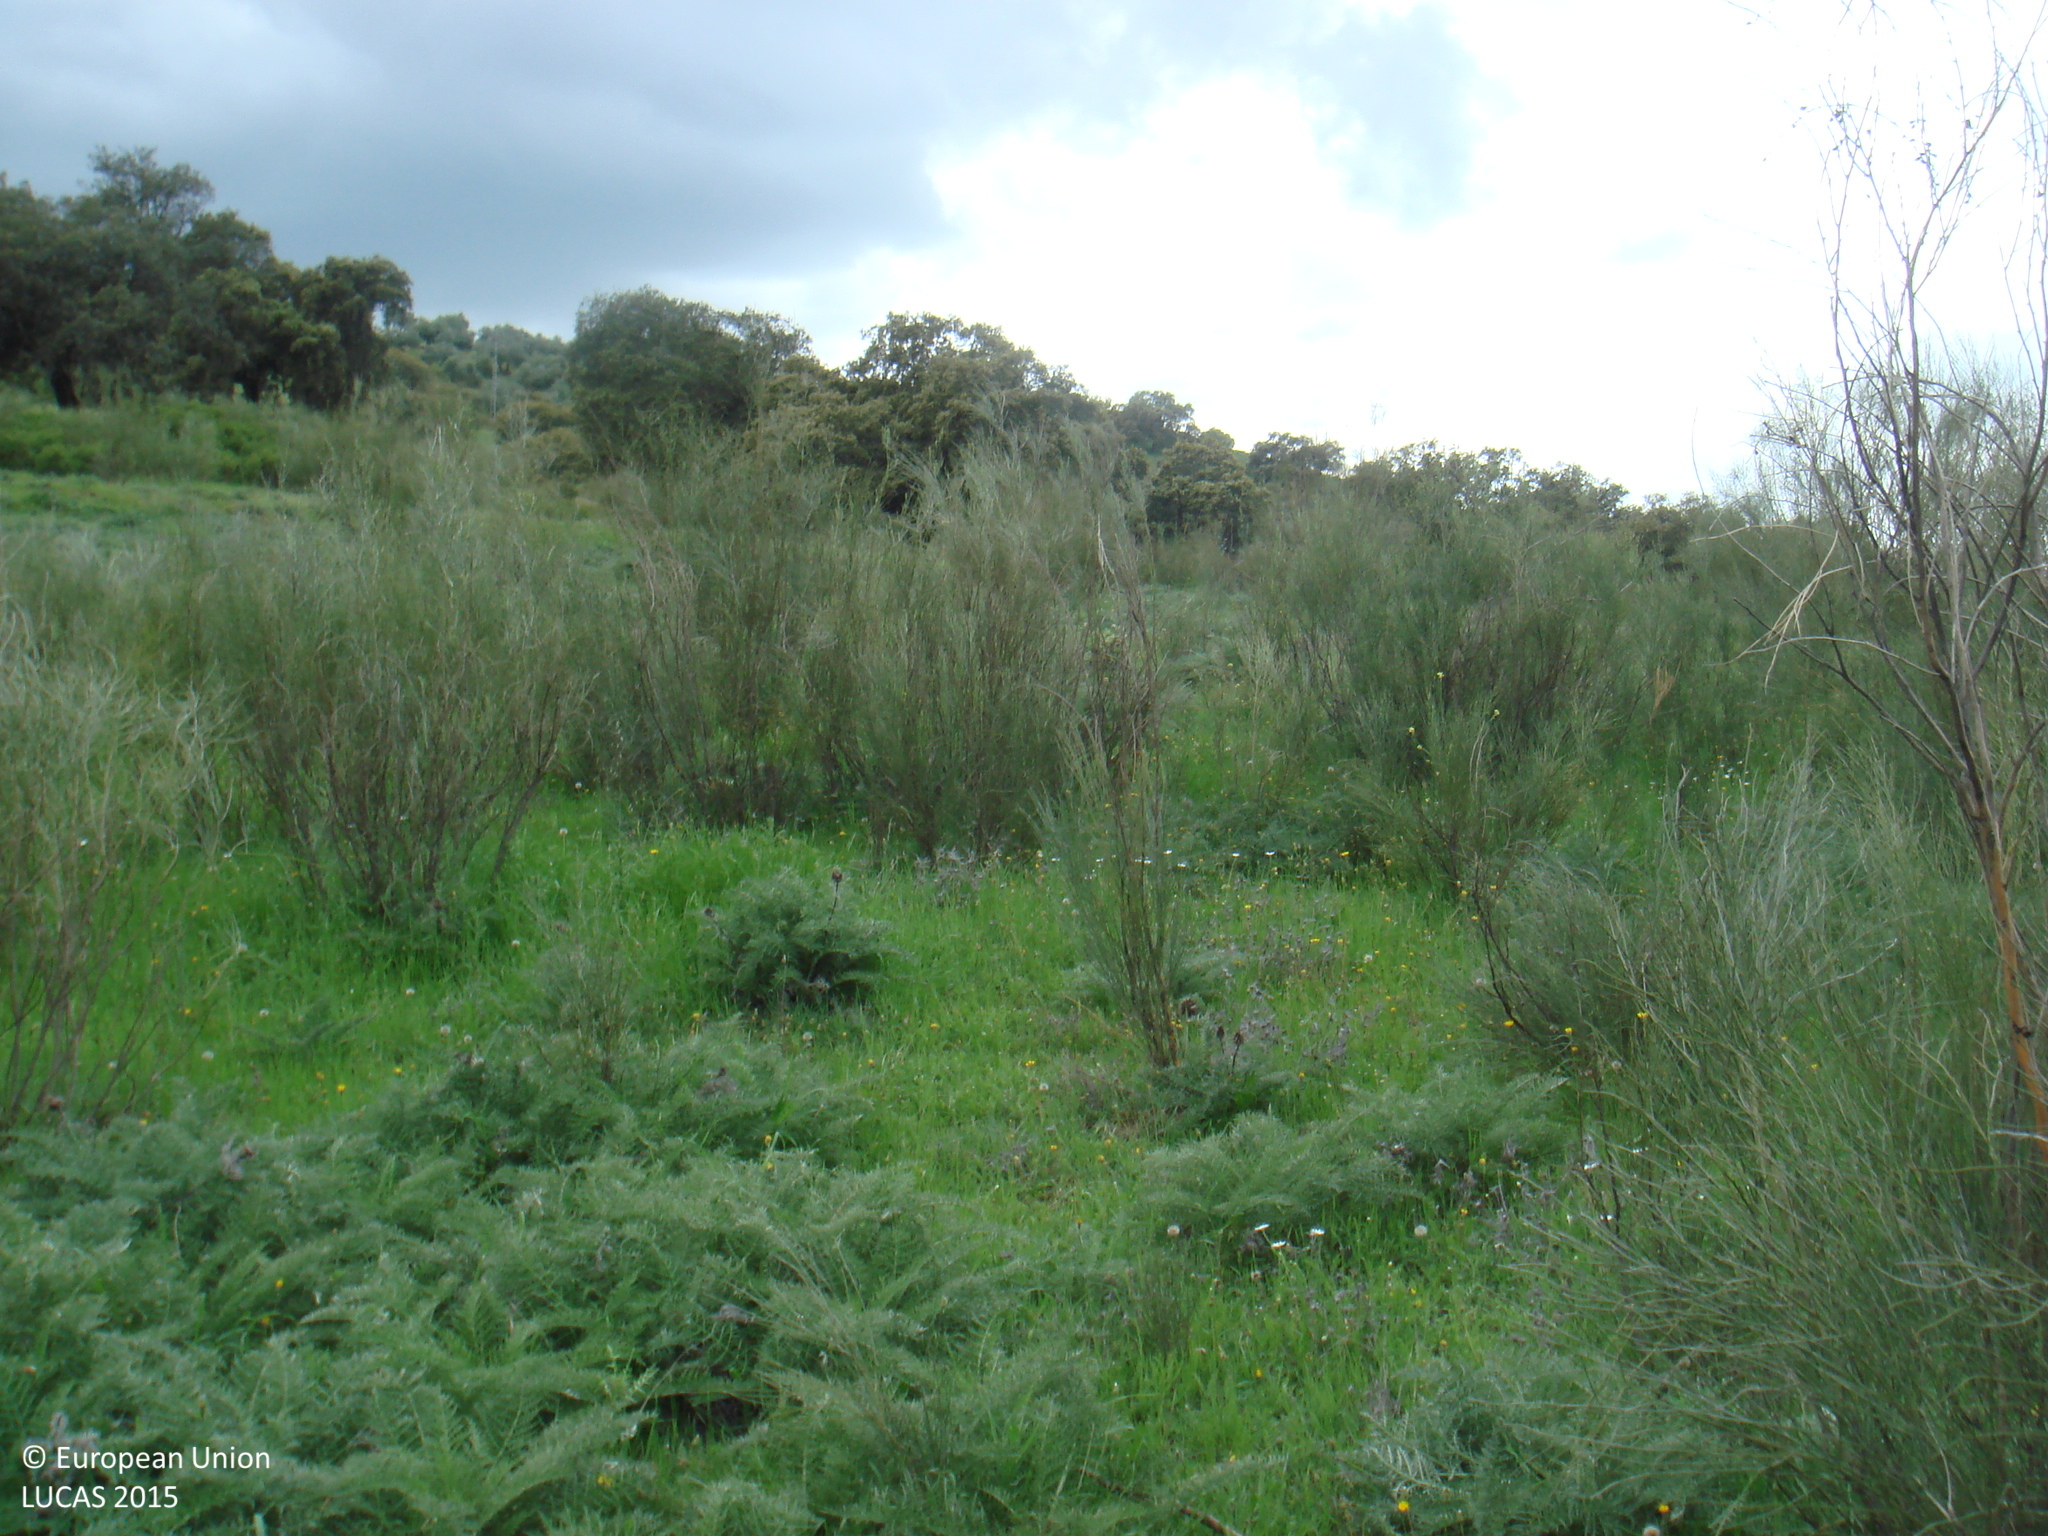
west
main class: Shrubland
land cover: Shrubland with sparse tree cover
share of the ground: > 75 %
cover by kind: shrubs 70 %, herbaceous plants 25 %, broadleaved forest trees 5 %
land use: Forestry
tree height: > 5 m
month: April
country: ES
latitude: 38.1823
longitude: -5.0354
